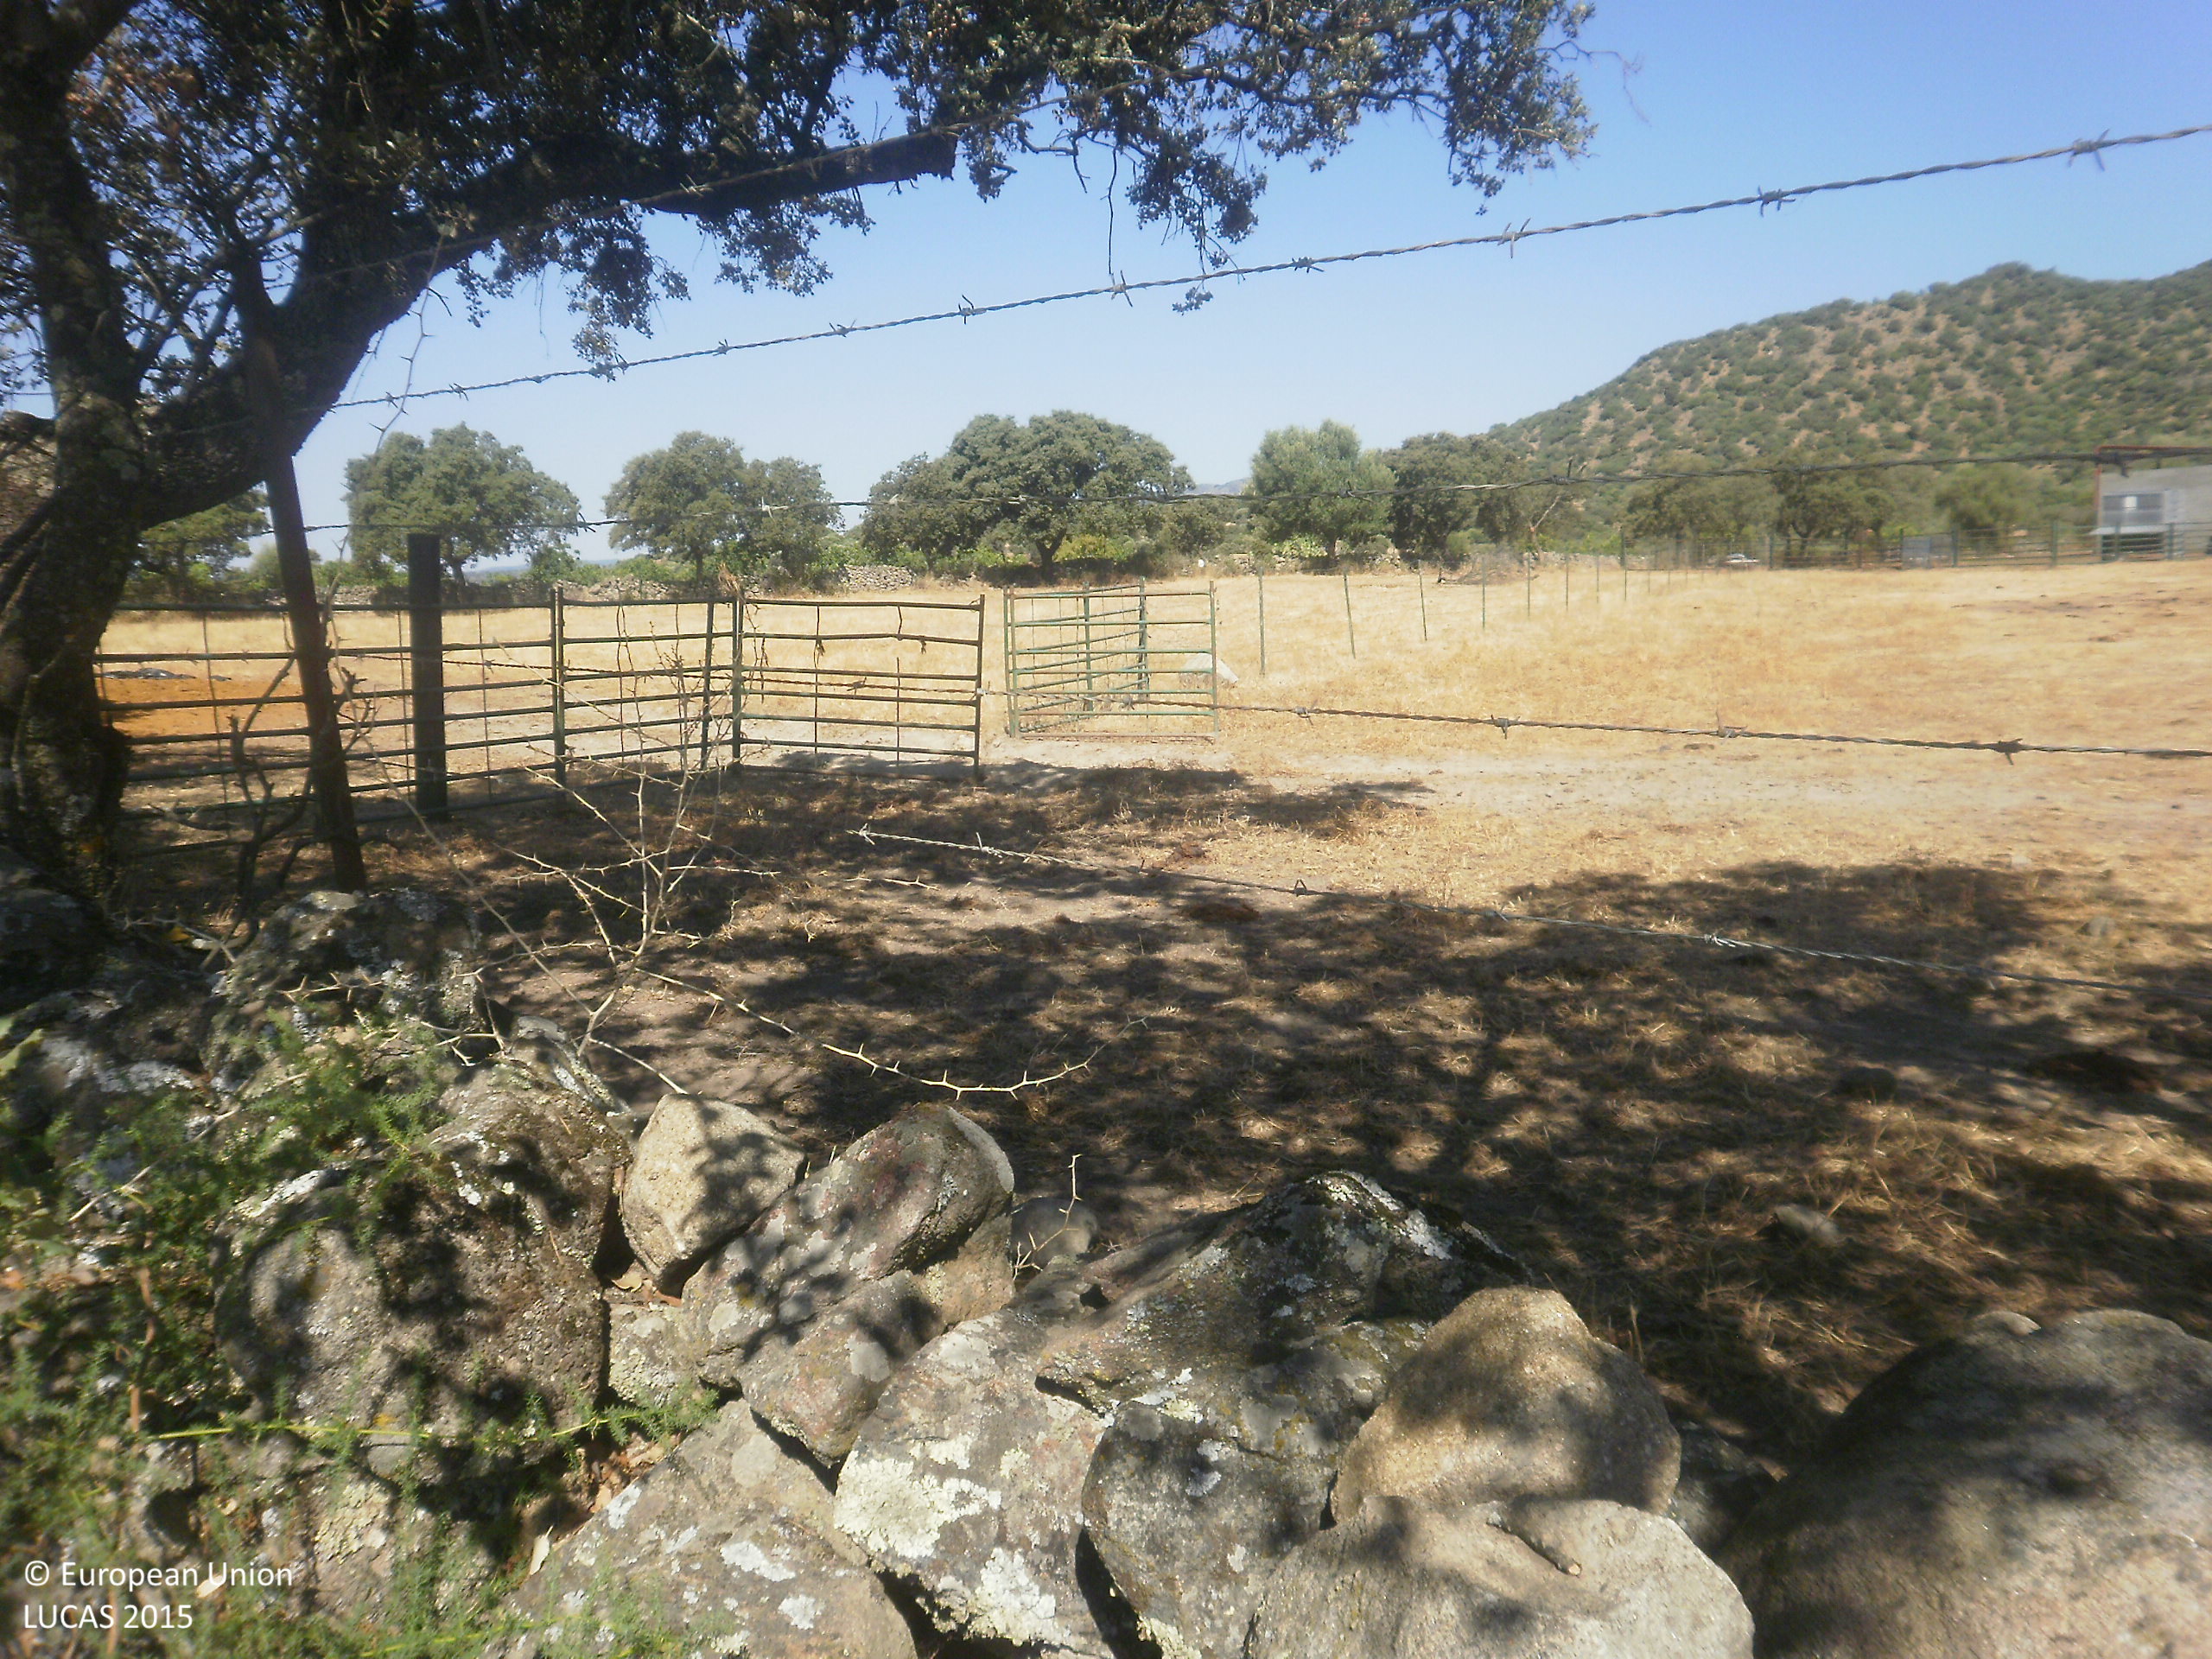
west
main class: Grassland
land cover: Grassland without tree/shrub cover
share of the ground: > 75 %
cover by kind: herbaceous plants 100 %
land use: Agriculture (excluding fallow land and kitchen gardens)
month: June
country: ES
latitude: 39.1806
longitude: -6.0196
